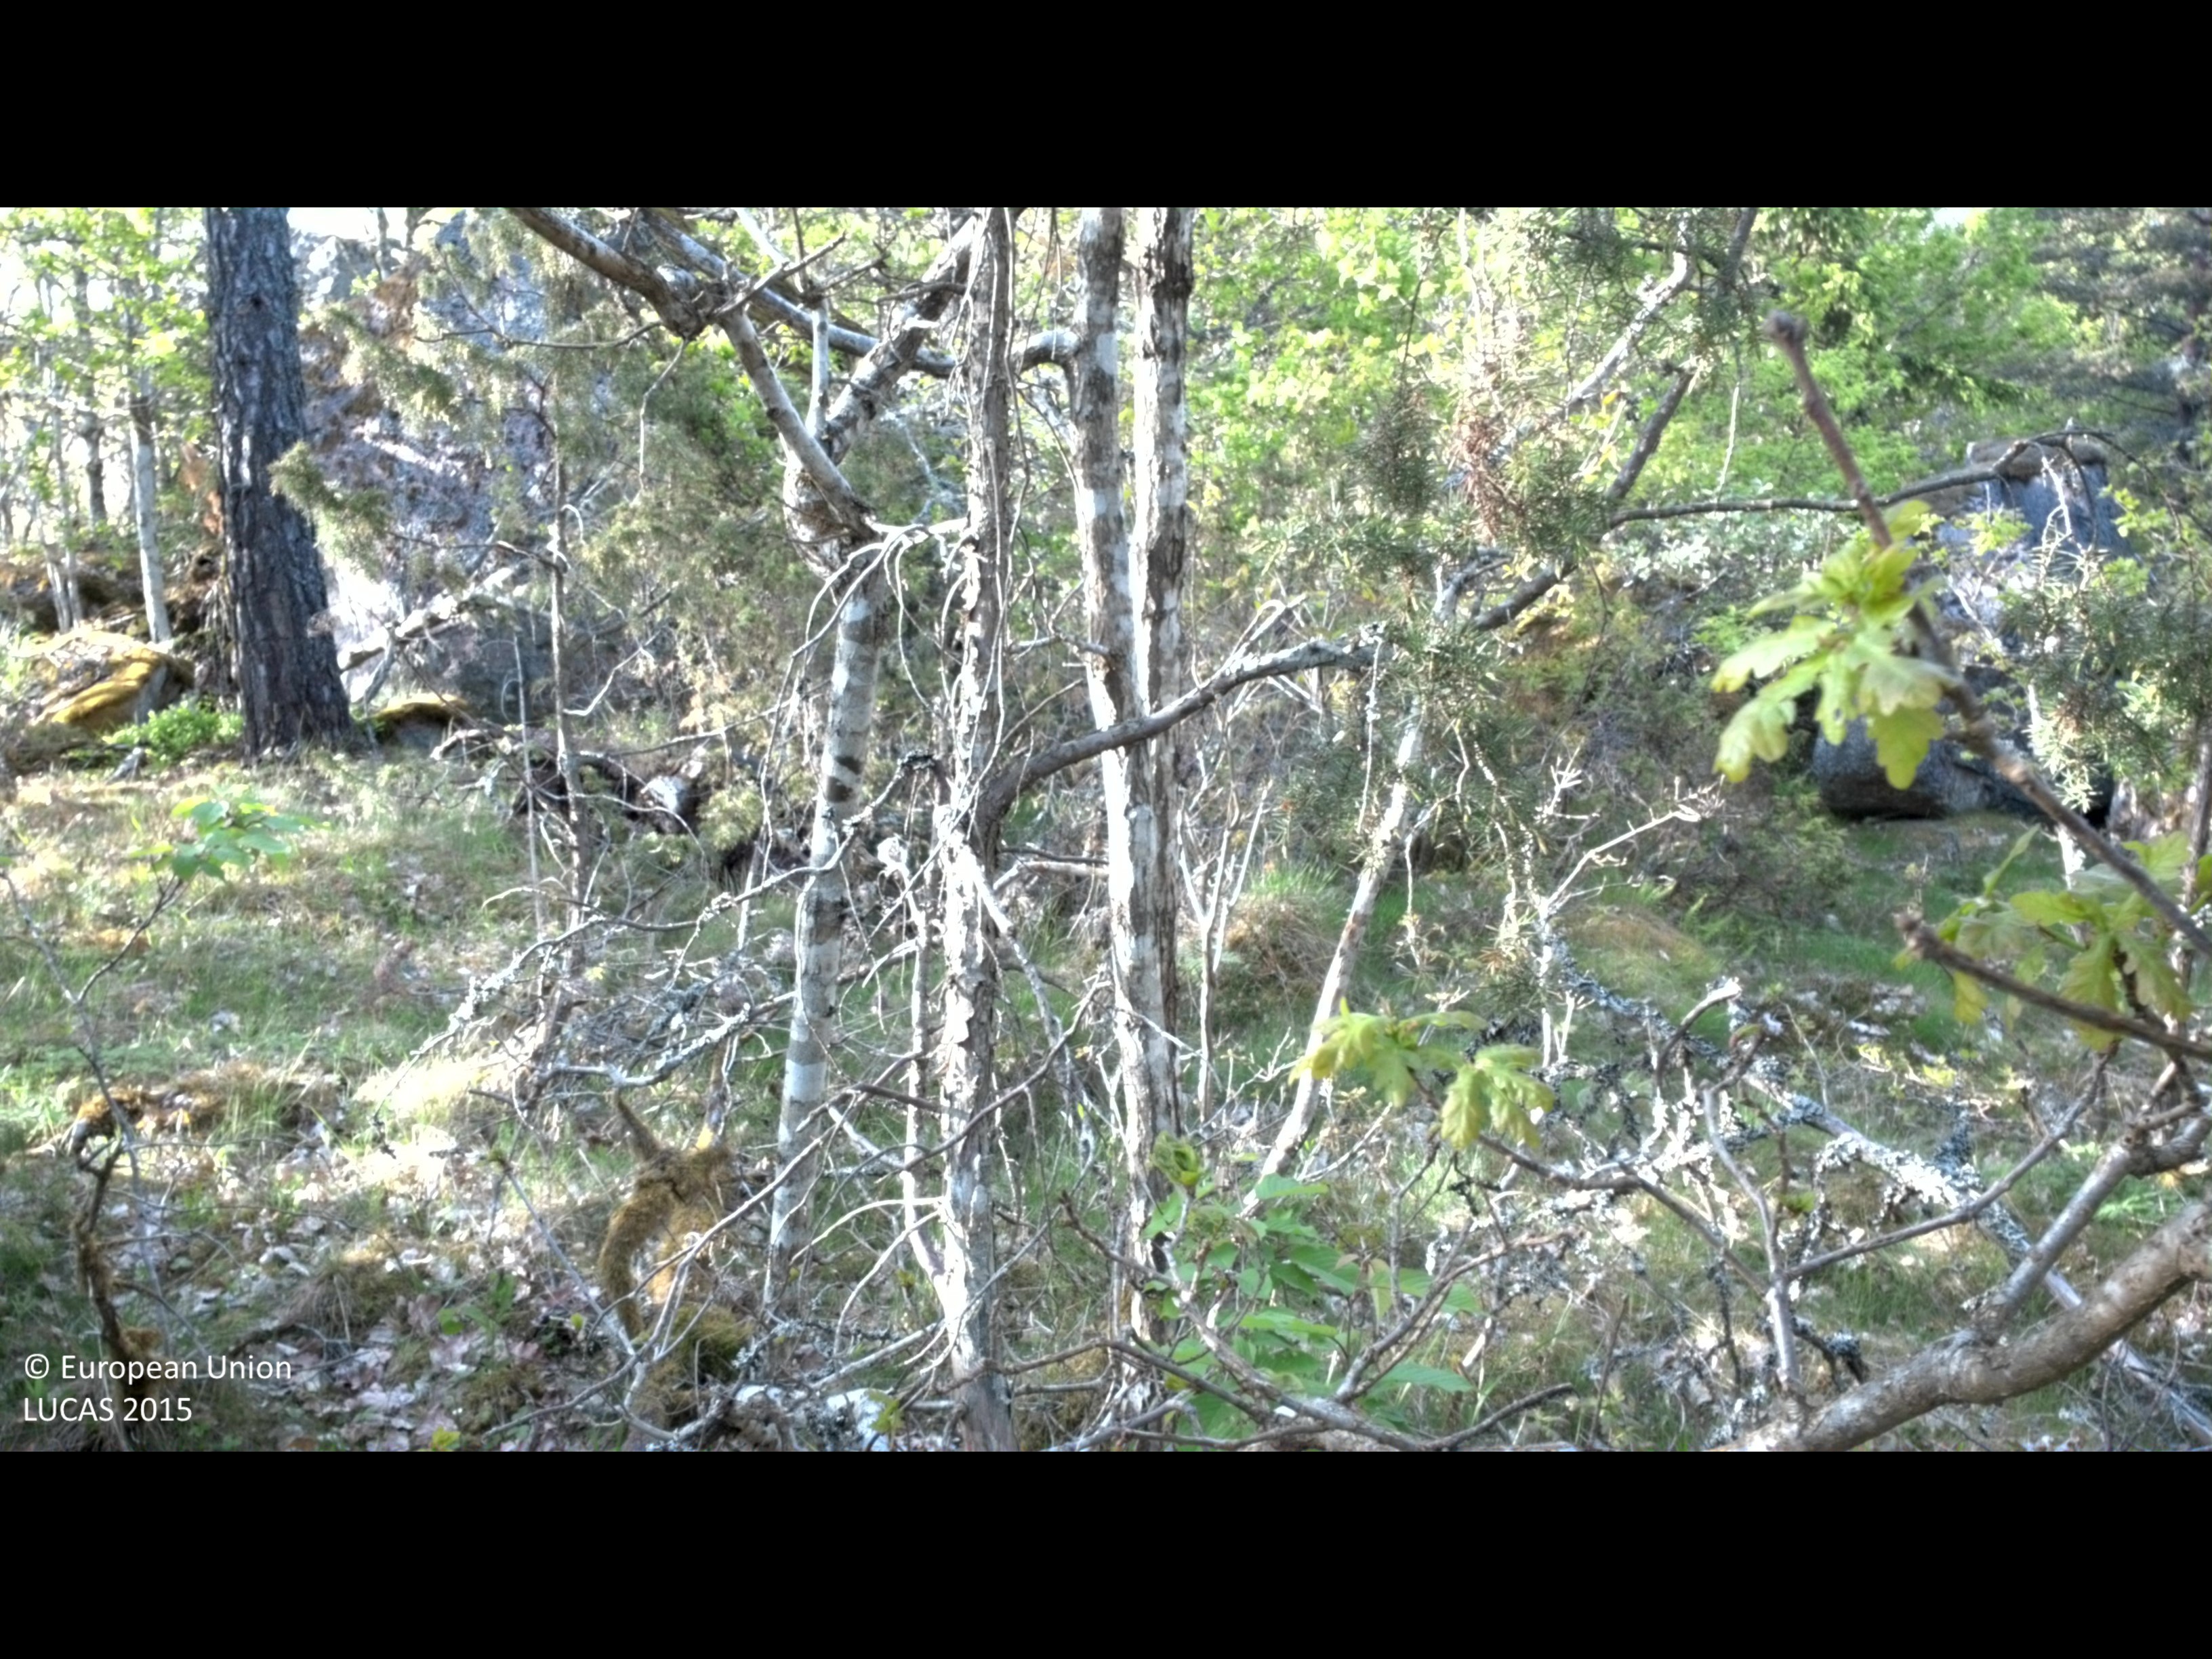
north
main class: Woodland
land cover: Pine dominated mixed woodland
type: boreal forest
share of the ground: > 75 %
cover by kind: broadleaved forest trees 60 %, coniferous forest trees 20 %, herbaceous plants 15 %, shrubs 5 %
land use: Forestry
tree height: > 5 m
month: May
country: SE
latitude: 57.3922
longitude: 16.1713
